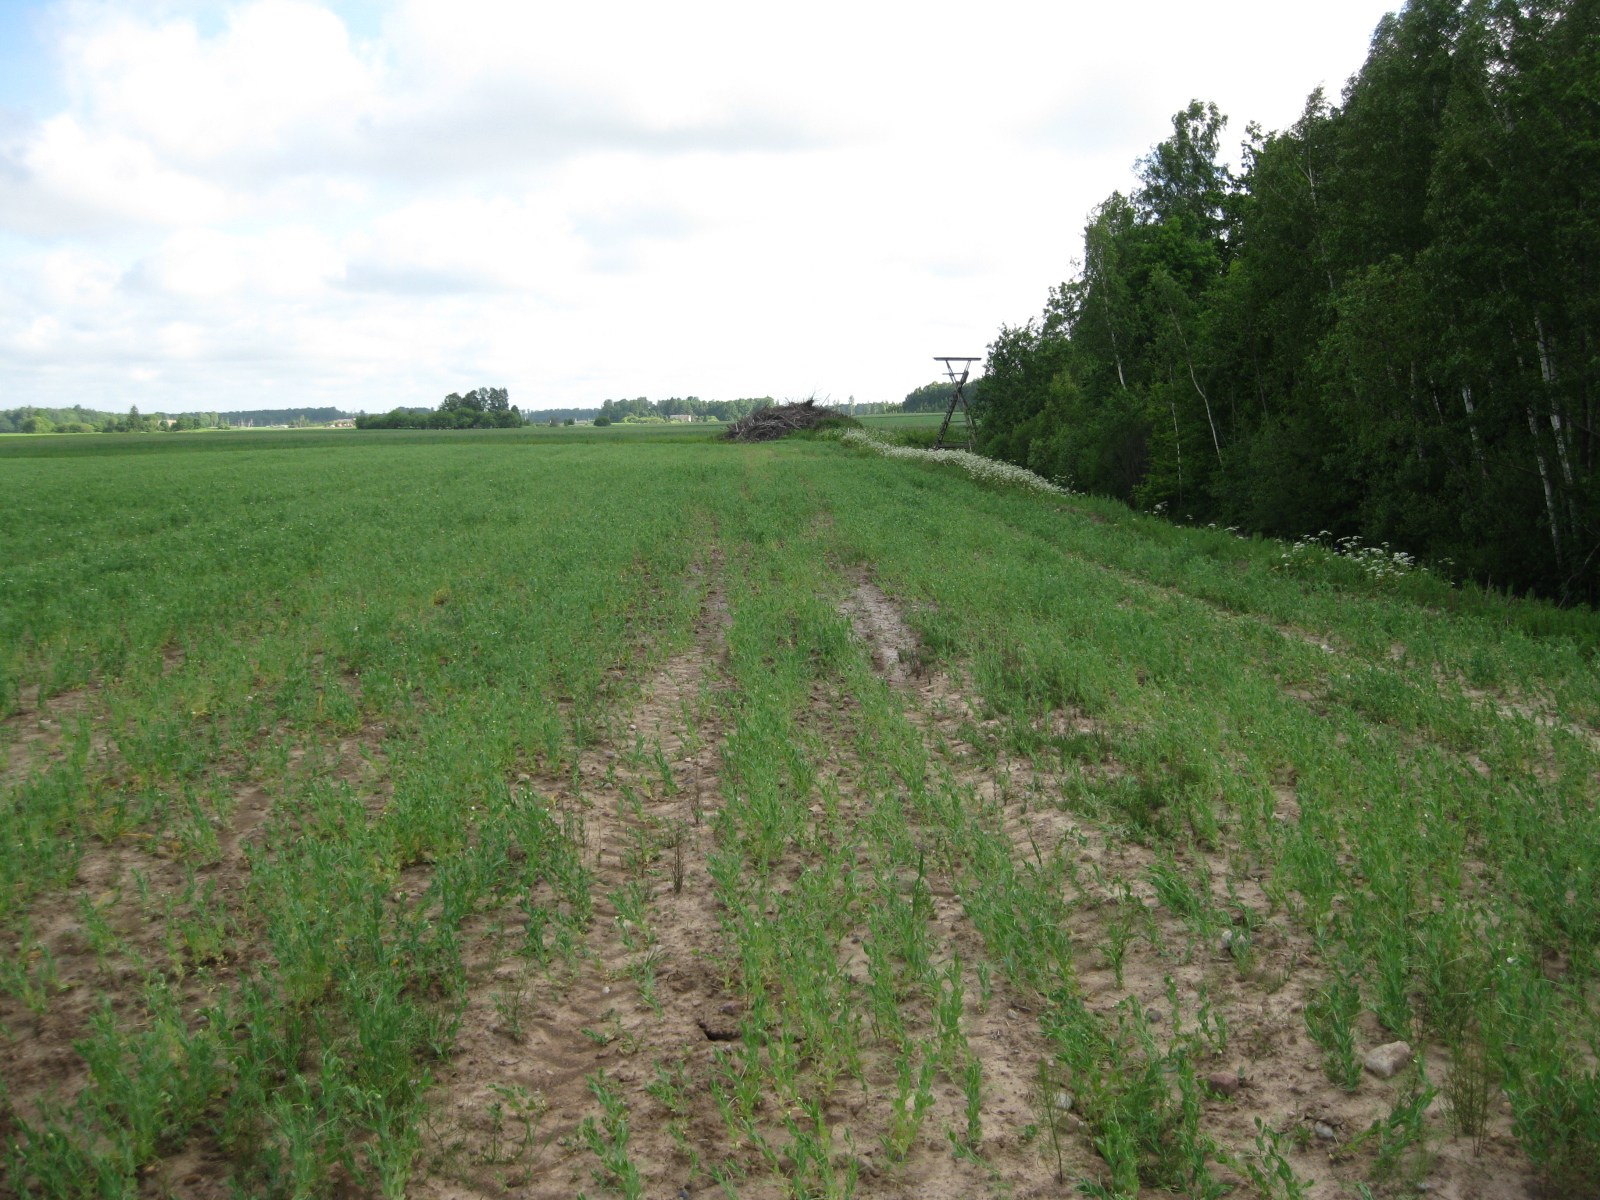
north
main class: Cropland
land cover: Dry pulses
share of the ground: 25 - 50 %
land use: Agriculture (excluding fallow land and kitchen gardens)
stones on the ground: < 10 %
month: June
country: LT
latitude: 55.1780
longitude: 23.6662
